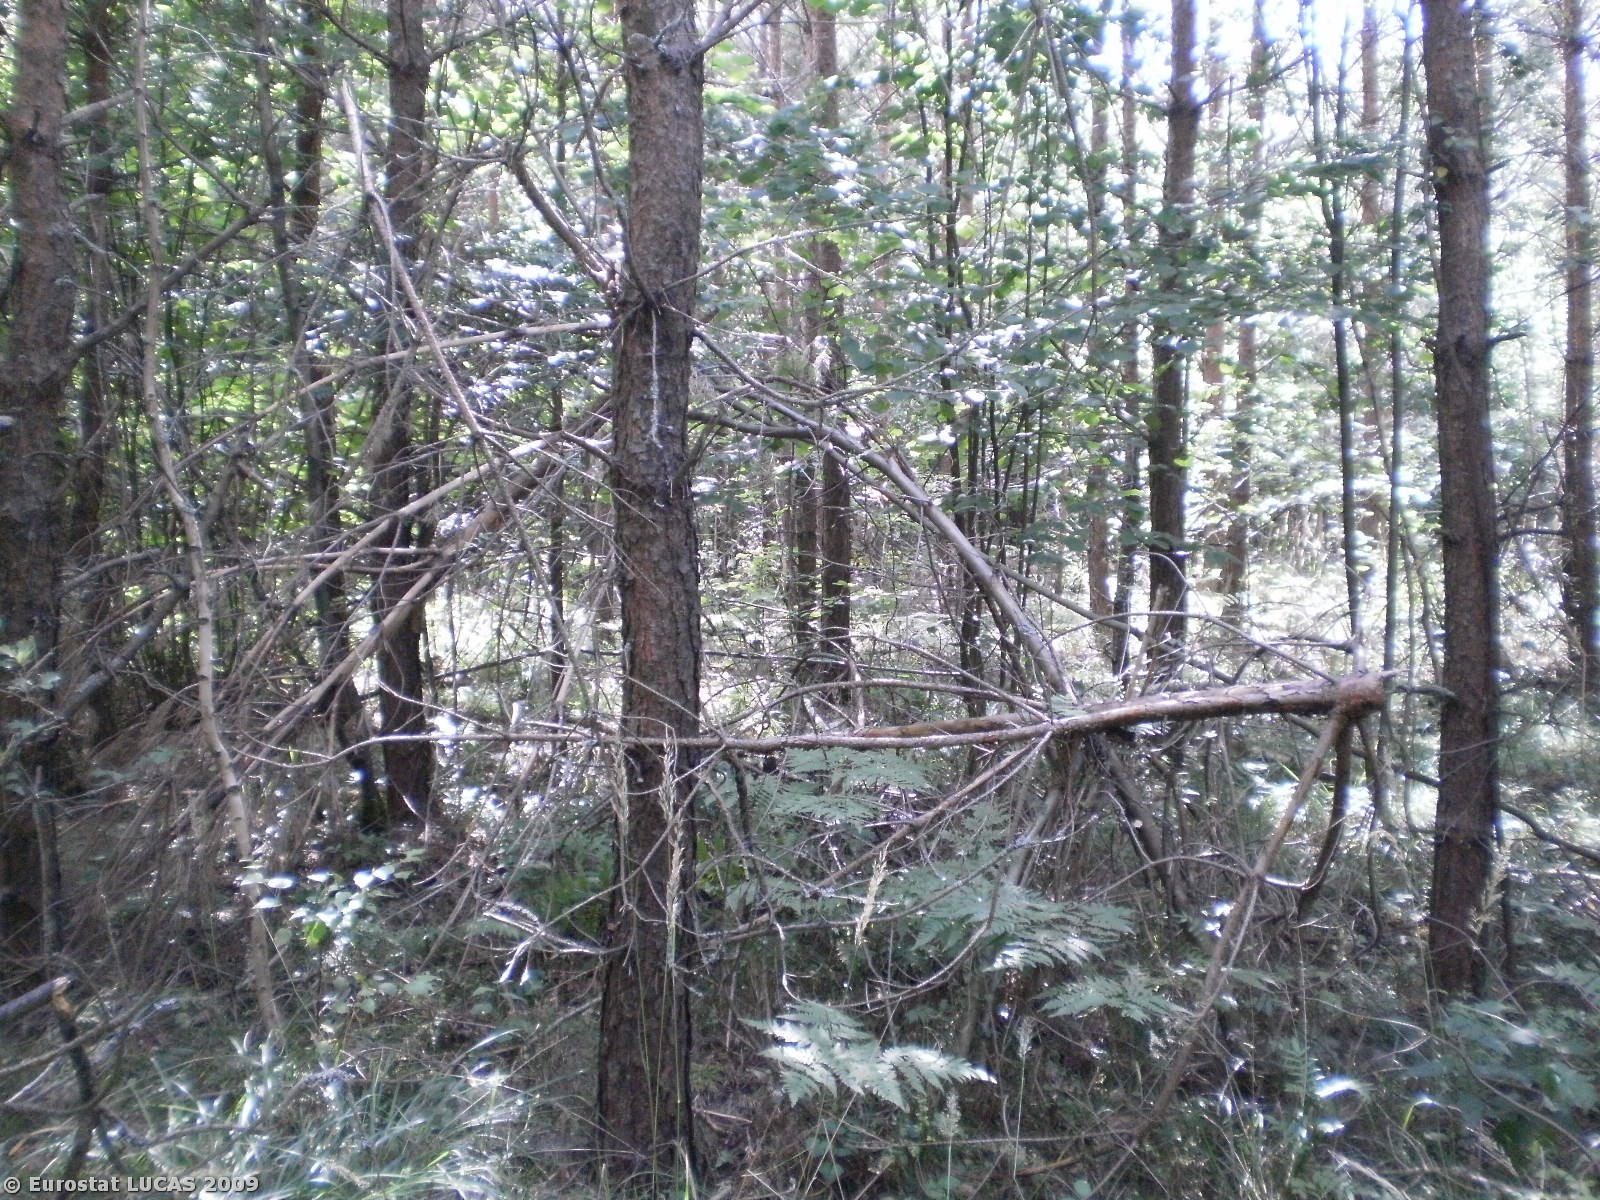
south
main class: Woodland
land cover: Mixed woodland
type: hemiboreal forest and nemoral coniferous forest and mixed broadleaved-coniferous forest
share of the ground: > 75 %
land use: Forestry
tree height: > 5 m
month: July
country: PL
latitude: 53.4136
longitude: 20.5239
